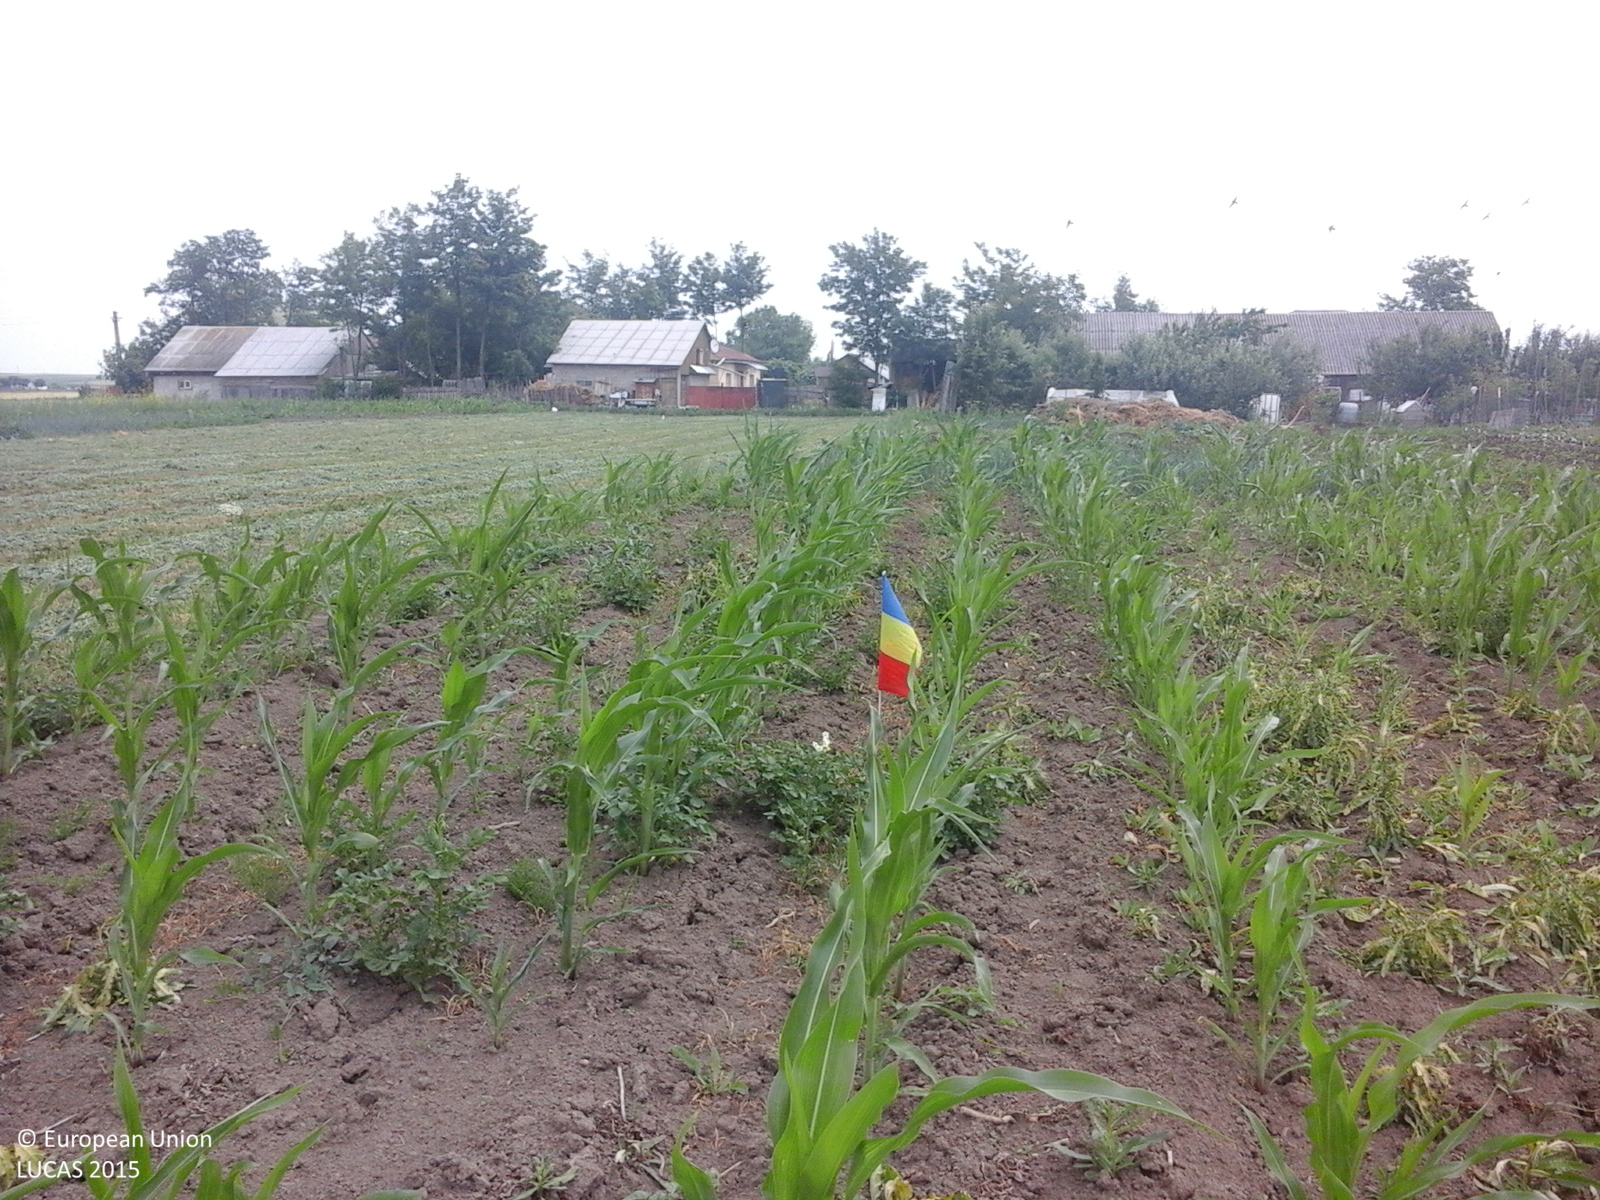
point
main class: Cropland
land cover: Maize
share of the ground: 25 - 50 %
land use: Agriculture (excluding fallow land and kitchen gardens)
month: June
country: RO
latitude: 47.5776
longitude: 26.4813
